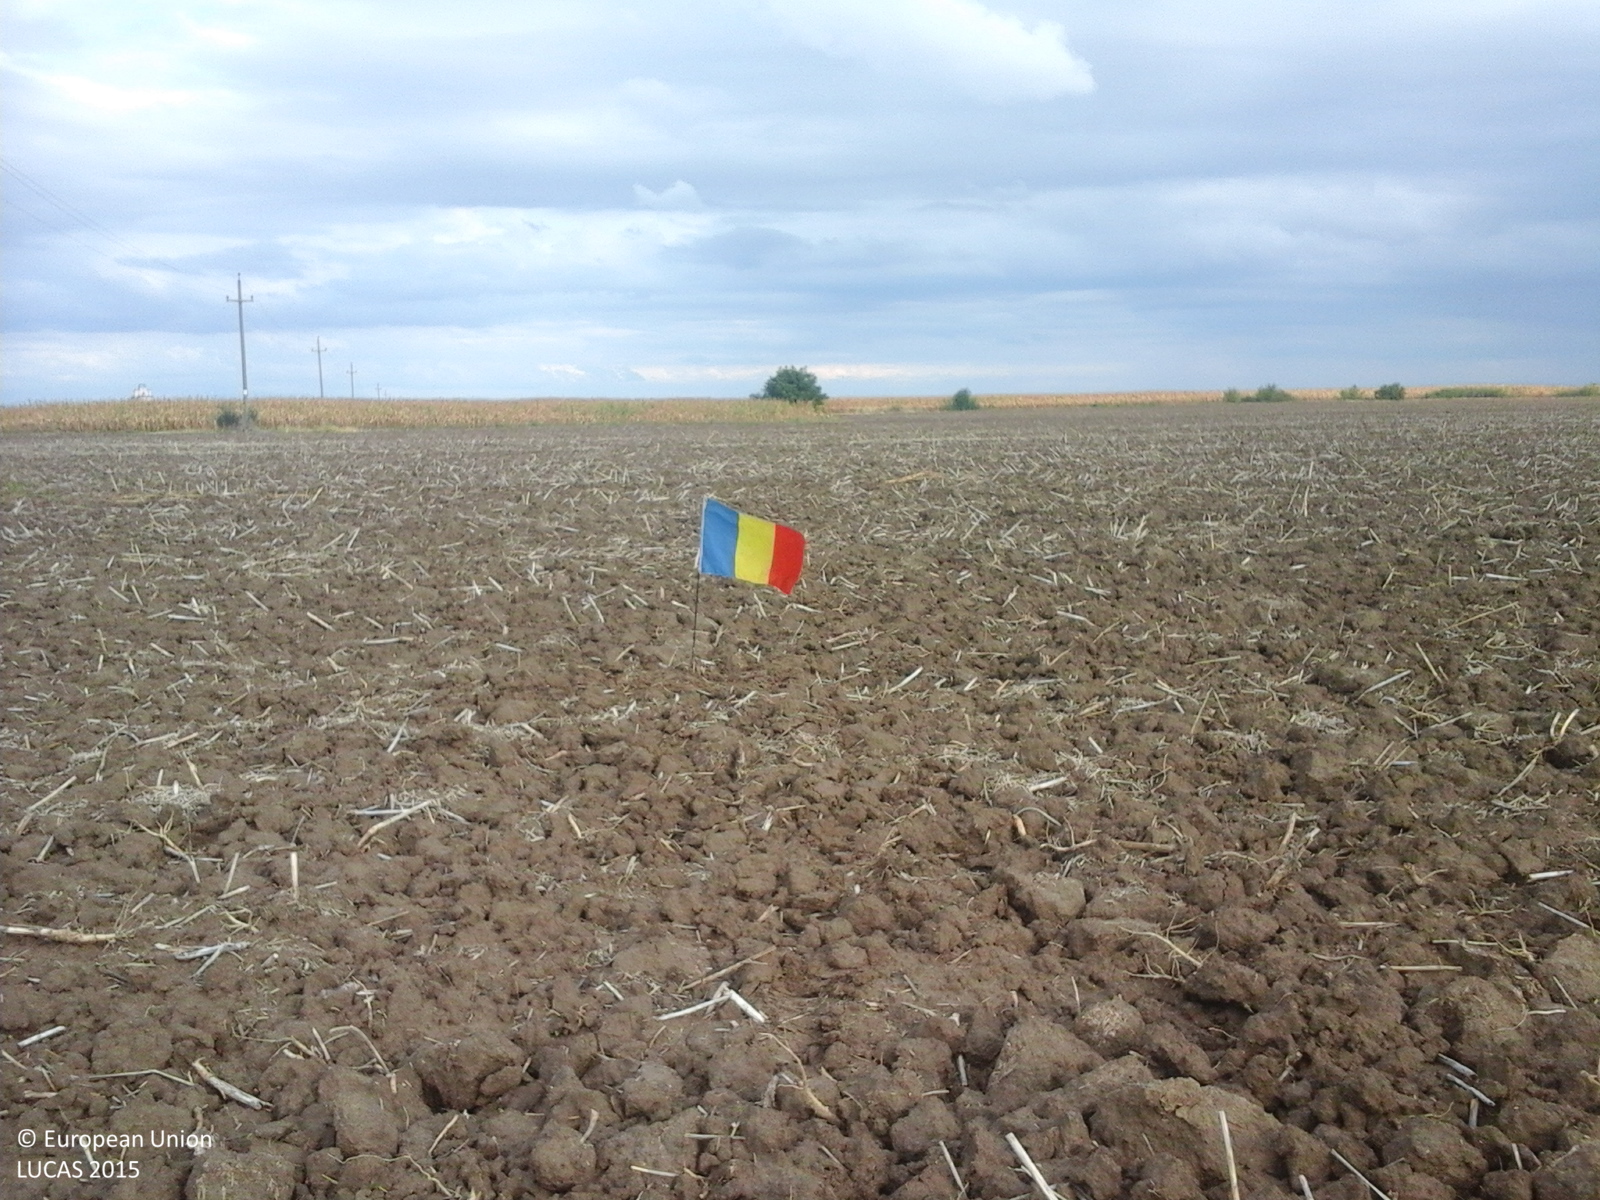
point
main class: Cropland
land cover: Rape and turnip rape
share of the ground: < 10 %
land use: Agriculture (excluding fallow land and kitchen gardens)
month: August
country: RO
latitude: 45.7728
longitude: 21.5961
